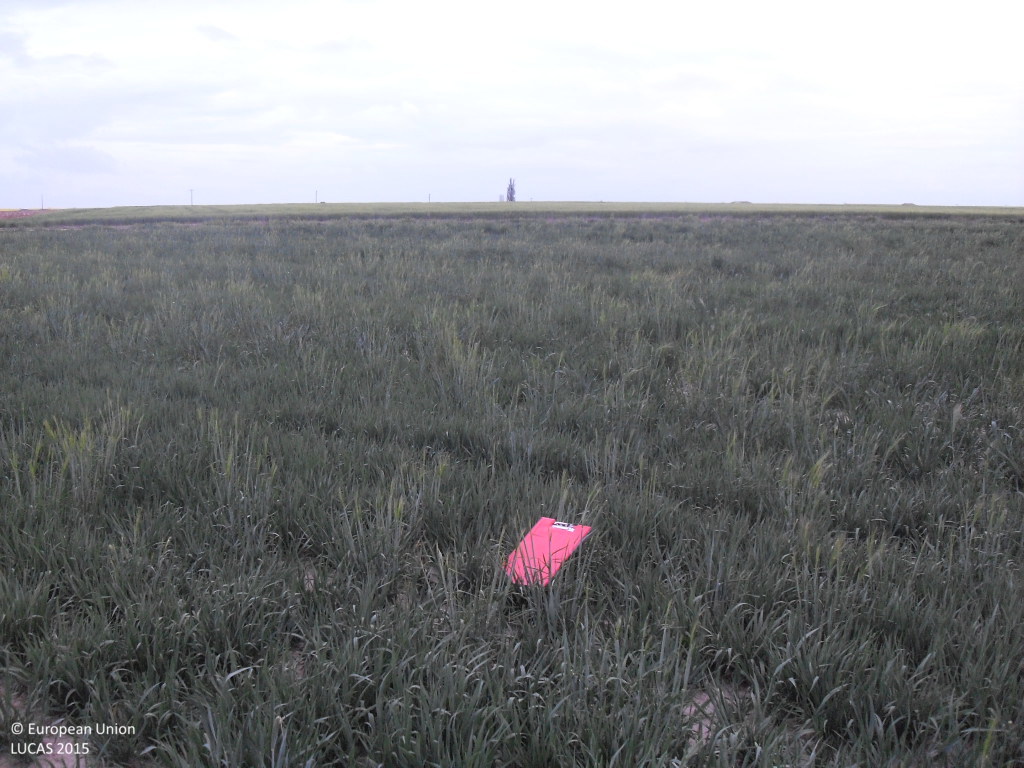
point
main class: Cropland
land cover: Oats
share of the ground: > 75 %
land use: Agriculture (excluding fallow land and kitchen gardens)
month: April
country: ES
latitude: 40.9781
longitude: -5.2461
